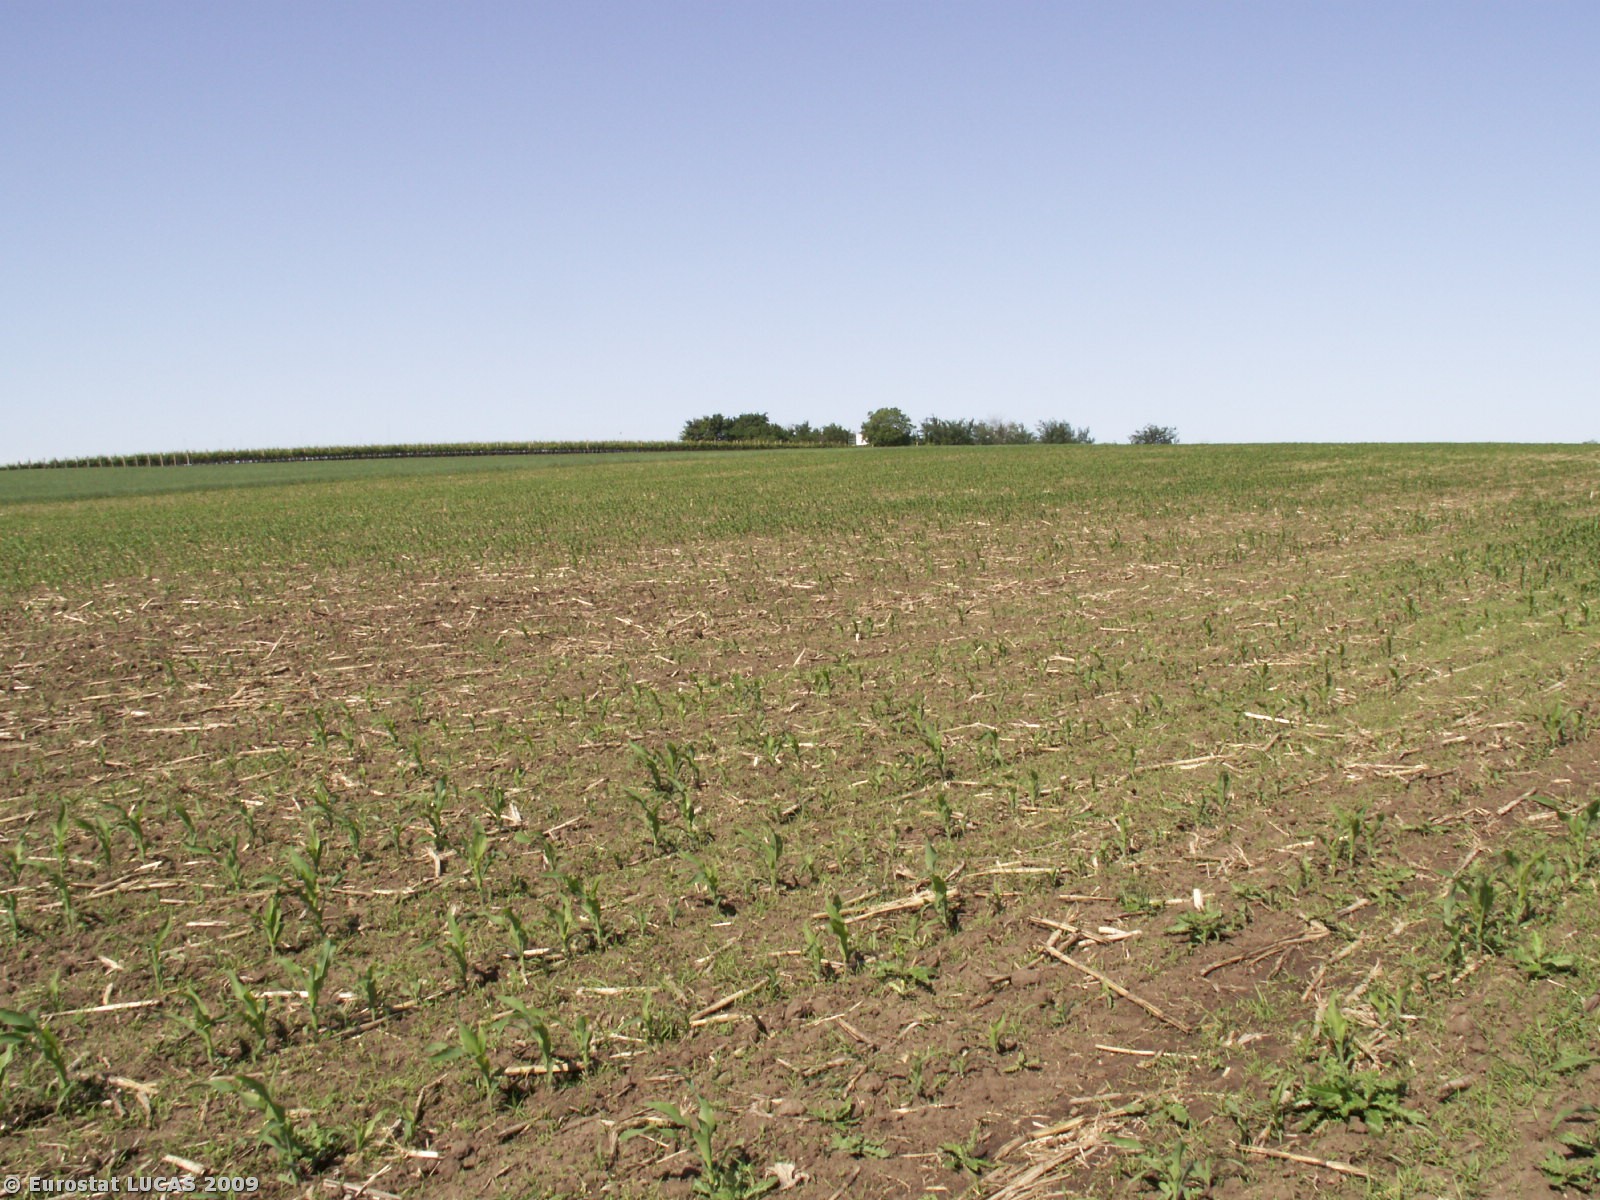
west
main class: Cropland
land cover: Other fresh vegetables
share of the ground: < 10 %
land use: Agriculture (excluding fallow land and kitchen gardens)
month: June
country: CZ
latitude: 48.8973
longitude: 16.5133
